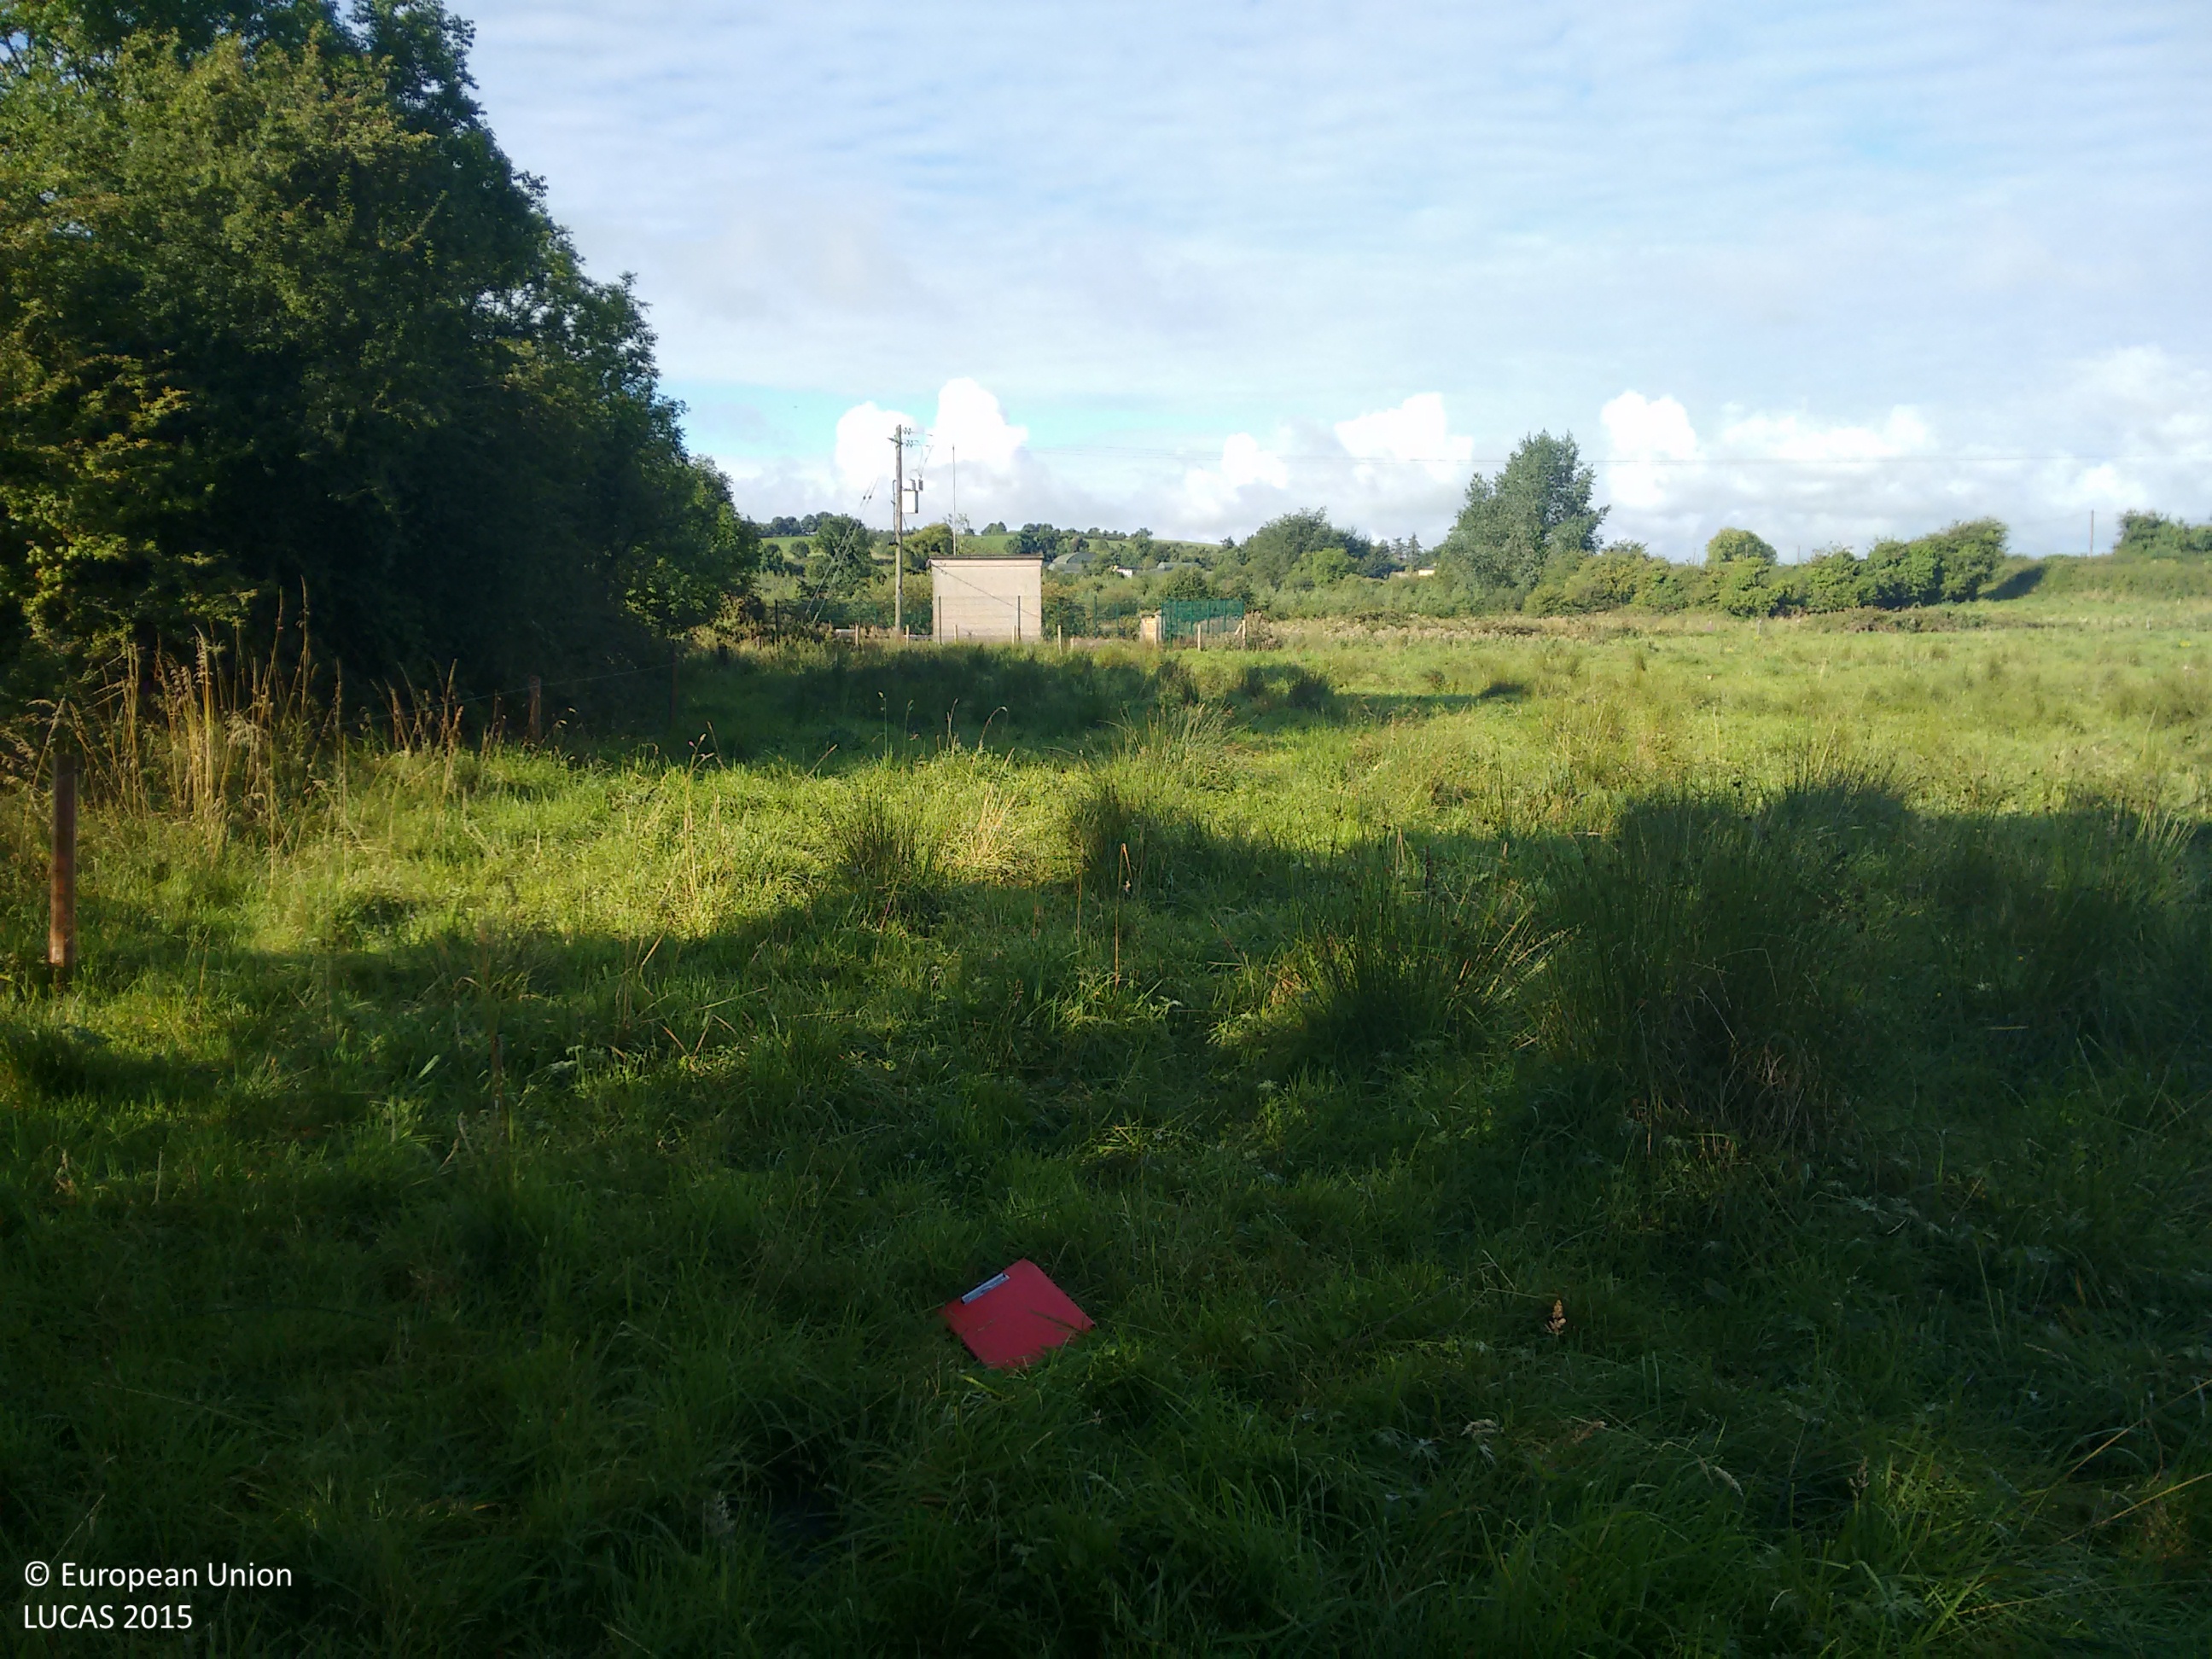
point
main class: Grassland
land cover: Grassland without tree/shrub cover
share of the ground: > 75 %
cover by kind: herbaceous plants 100 %
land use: Agriculture (excluding fallow land and kitchen gardens)
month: August
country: IE
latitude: 52.5291
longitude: -8.2723
